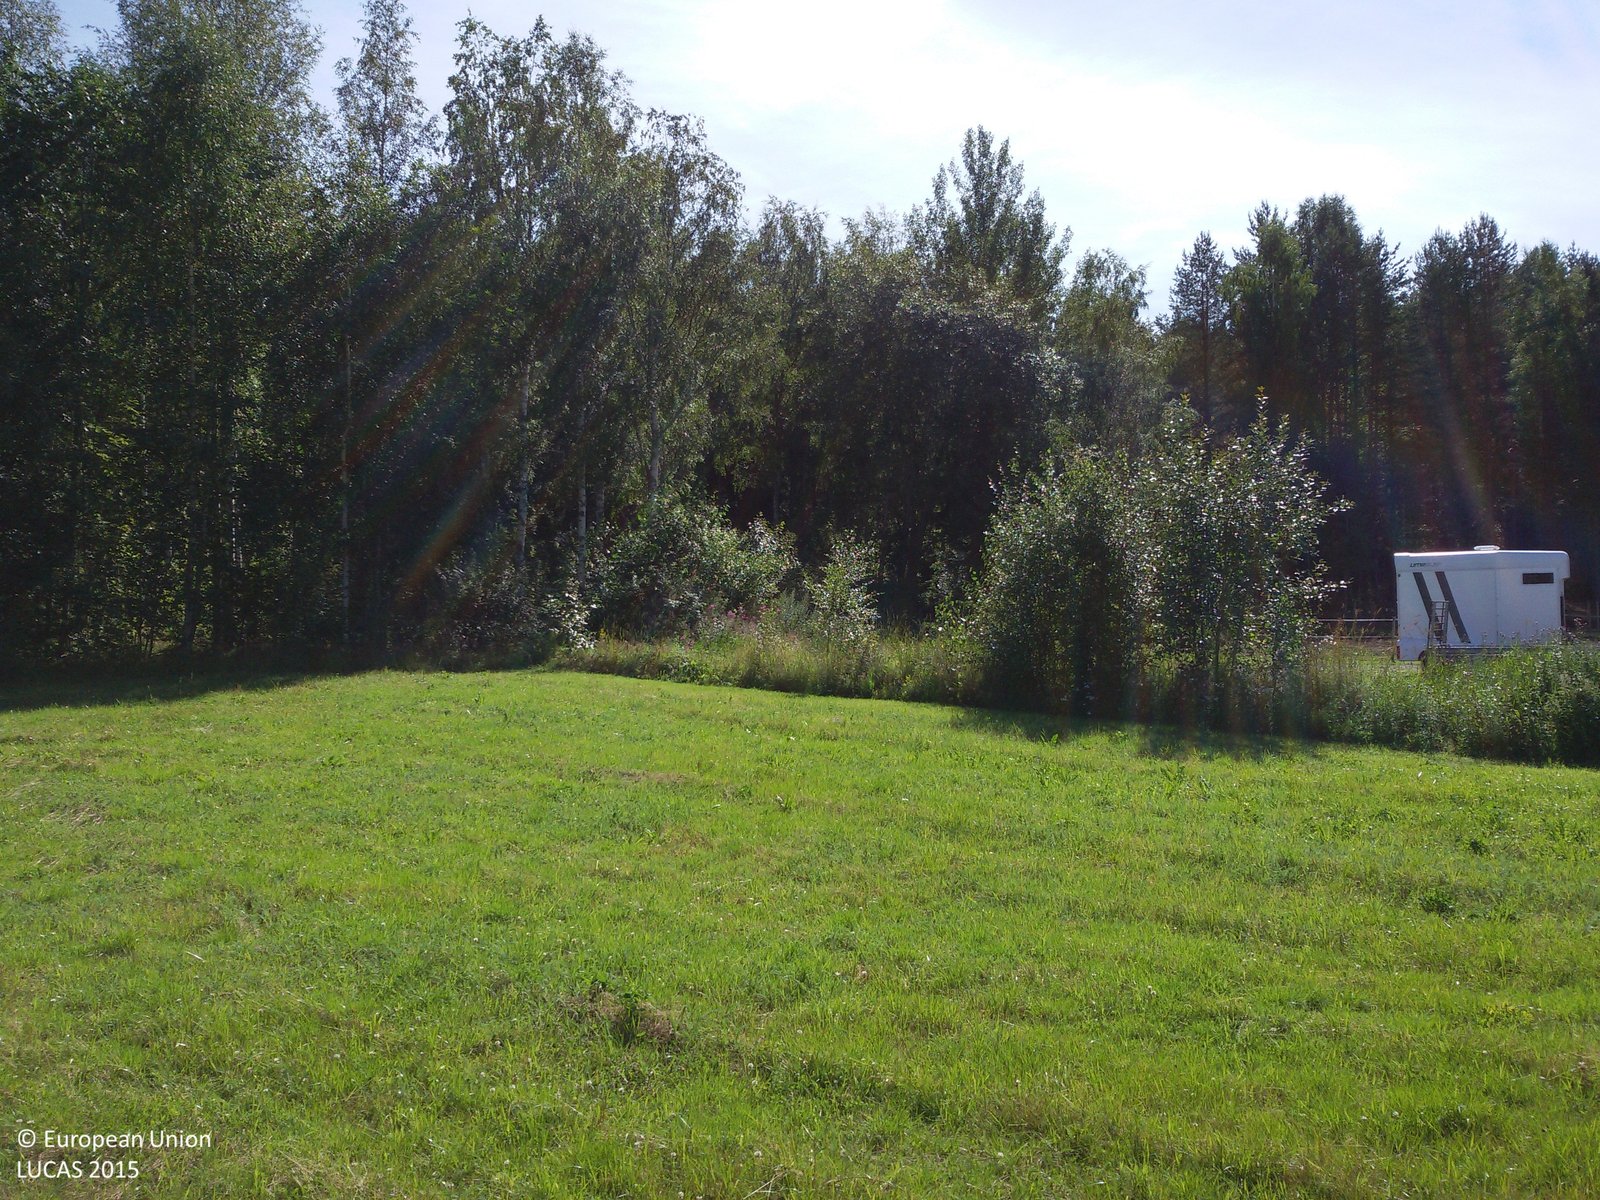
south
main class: Grassland
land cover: Grassland without tree/shrub cover
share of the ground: > 75 %
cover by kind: herbaceous plants 100 %
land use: Agriculture (excluding fallow land and kitchen gardens)
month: August
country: SE
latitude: 60.9557
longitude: 16.4308
